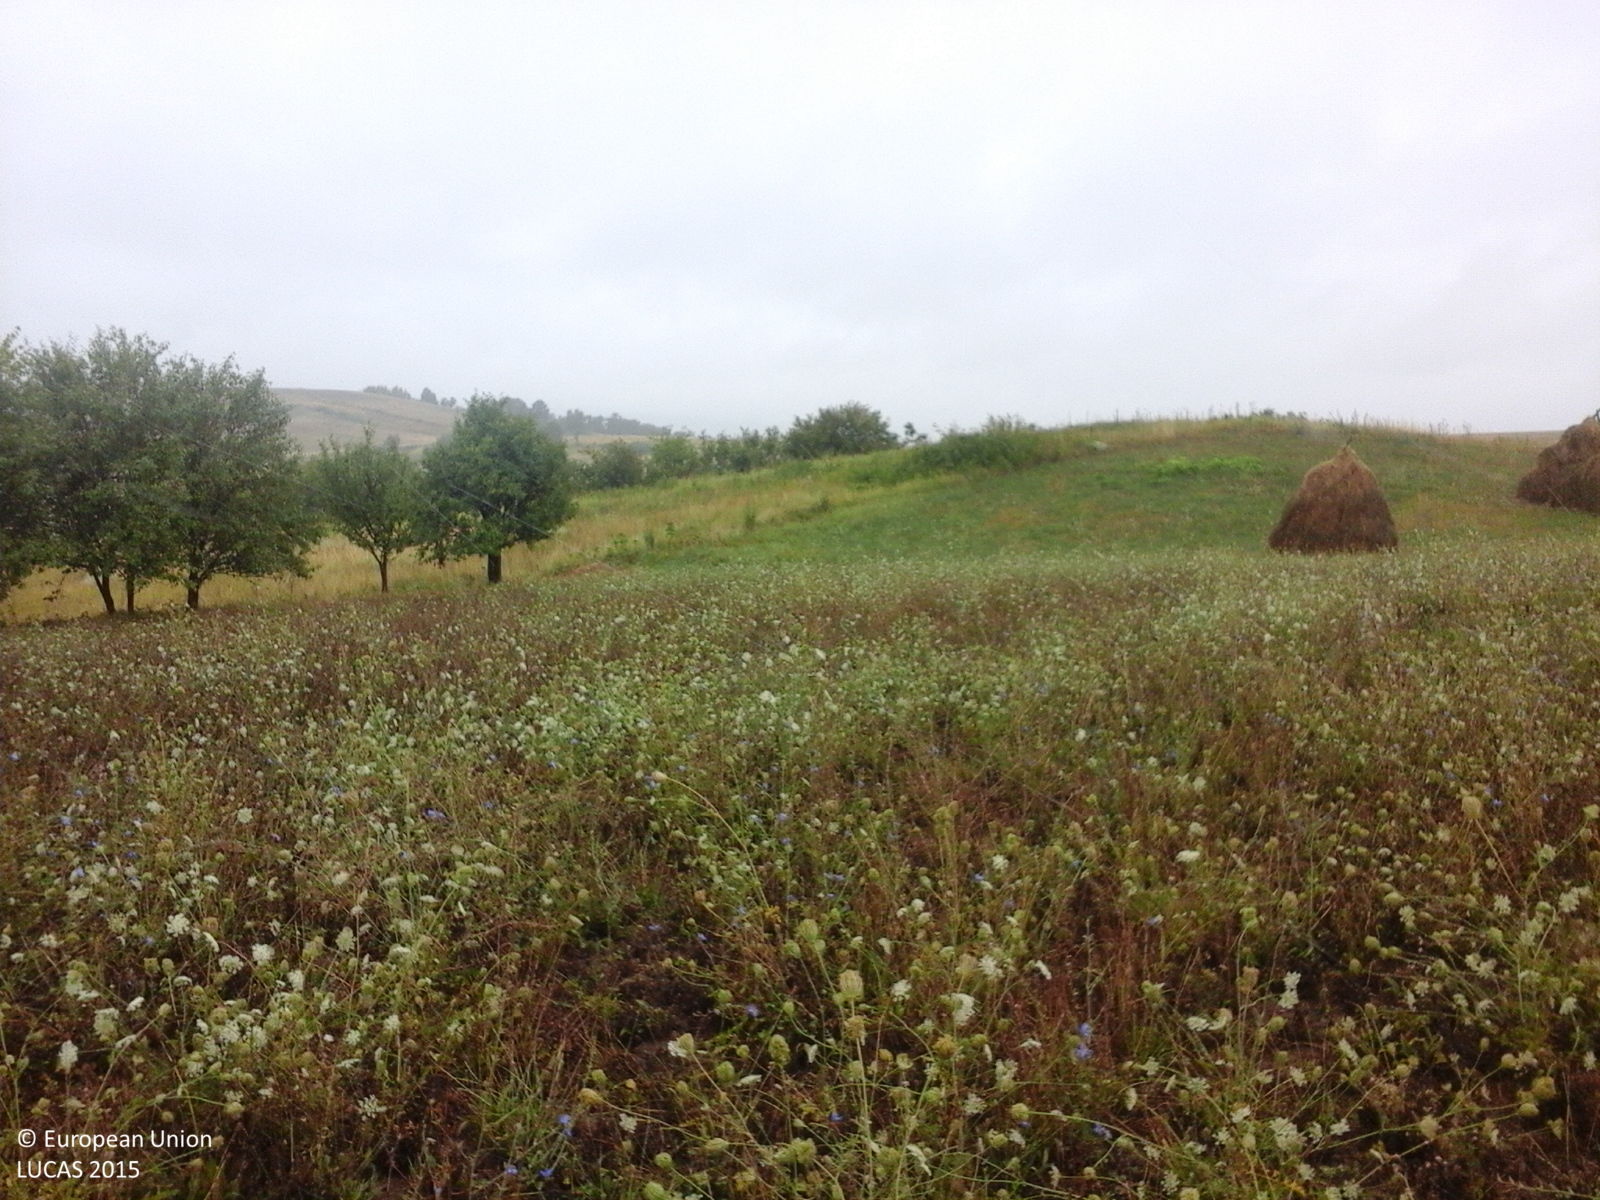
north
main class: Grassland
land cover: Spontaneously vegetated surfaces
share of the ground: > 75 %
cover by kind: herbaceous plants 100 %
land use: Fallow land
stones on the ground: 25 - 50 %
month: August
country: RO
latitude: 44.8814
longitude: 22.0749
